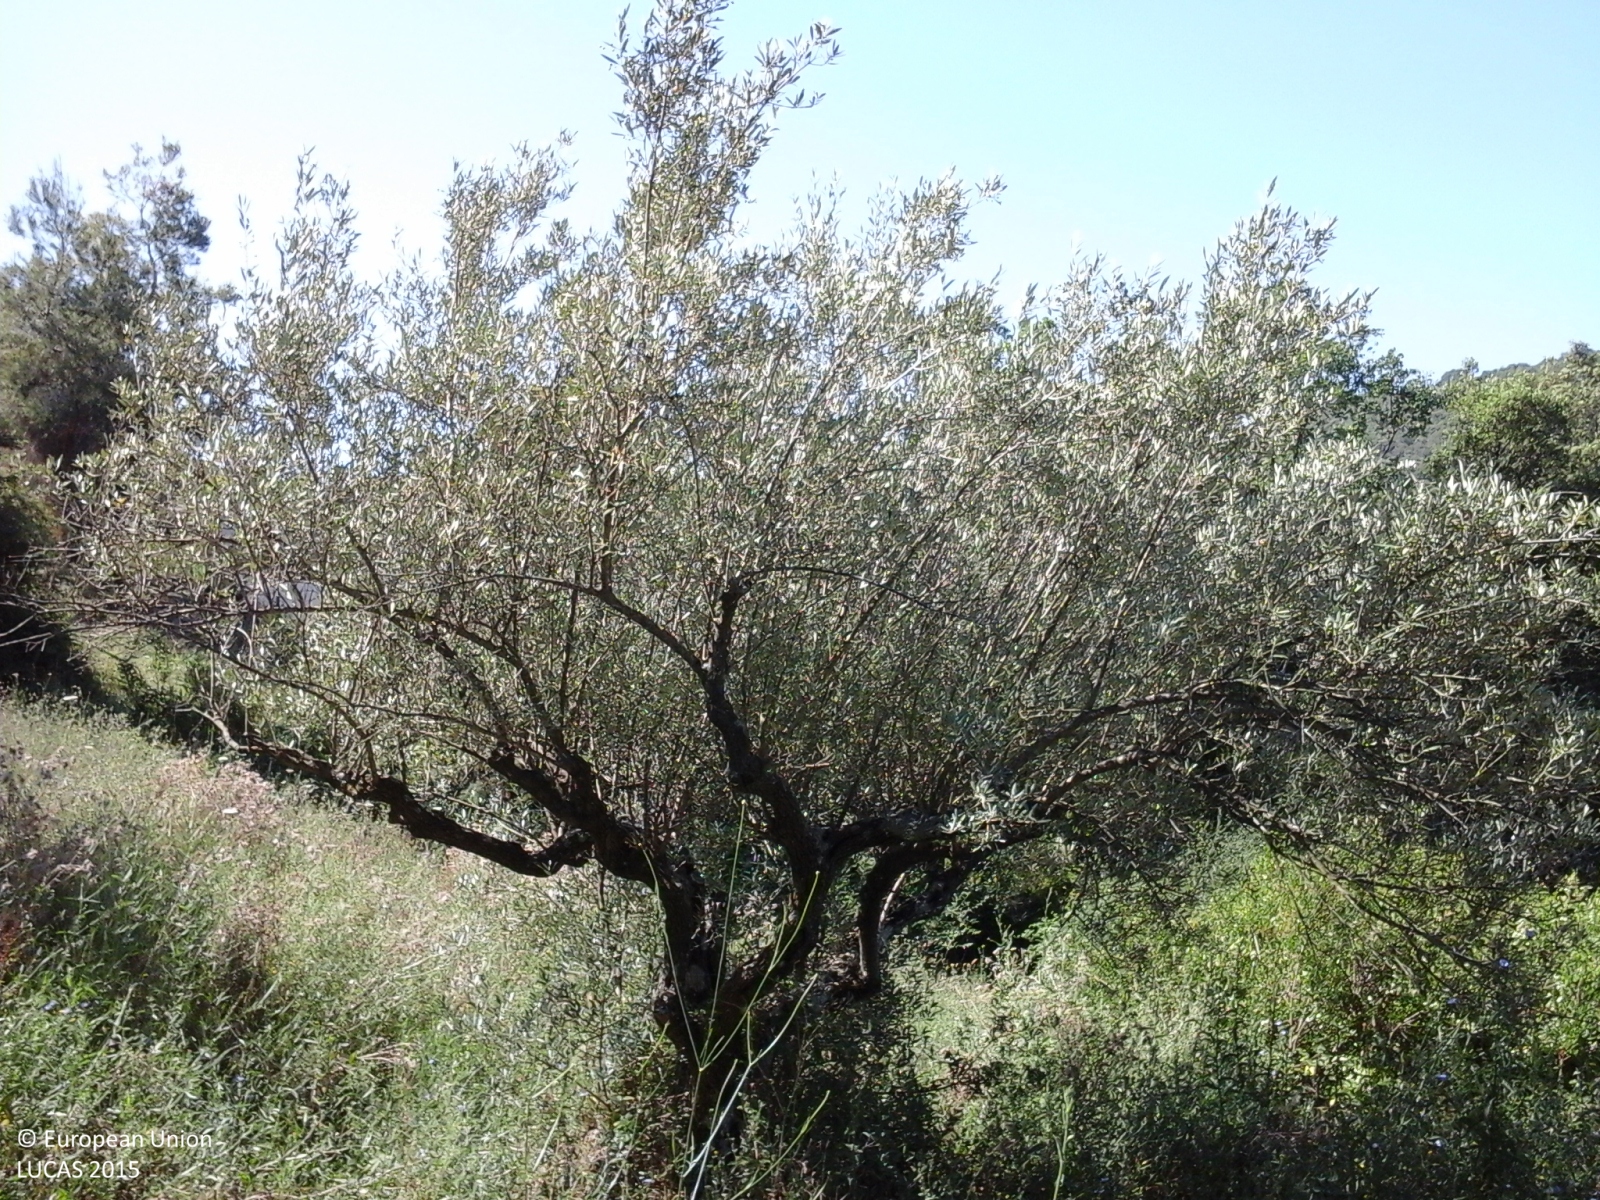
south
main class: Cropland
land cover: Olive groves
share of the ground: > 75 %
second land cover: Spontaneously vegetated surfaces
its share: > 75 %
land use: Kitchen garden
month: June
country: IT
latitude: 40.3715
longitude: 15.0775
